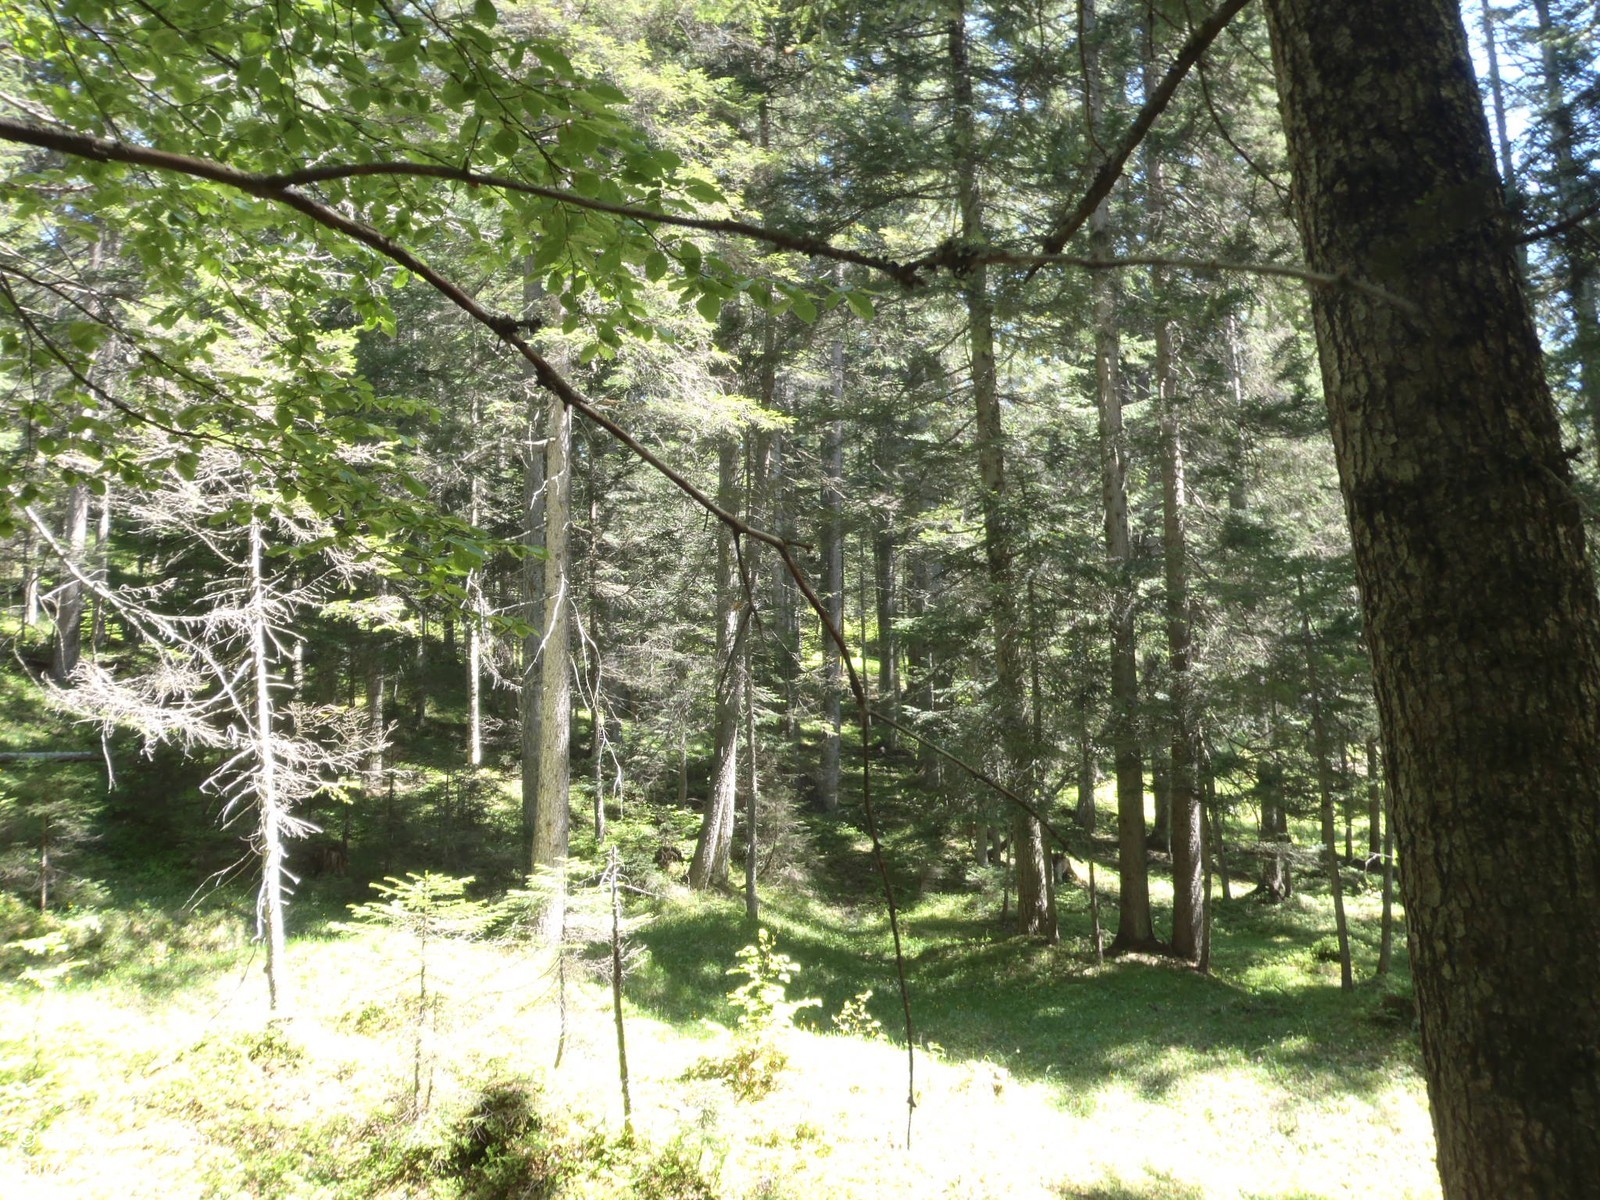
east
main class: Woodland
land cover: Spruce dominated mixed woodland
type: alpine coniferous forest
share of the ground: > 75 %
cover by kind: coniferous forest trees 70 %, broadleaved forest trees 25 %, shrubs 5 %
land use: Forestry
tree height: > 5 m
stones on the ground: < 10 %
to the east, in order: Spruce dominated mixed woodland; Tracks; Spruce dominated coniferous woodland; Grassland with sparse tree/shrub cover; Tracks; Grass margins; Tracks; Shruby margins; Spruce dominated mixed woodland
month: May
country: AT
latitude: 47.3712
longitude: 11.1776
